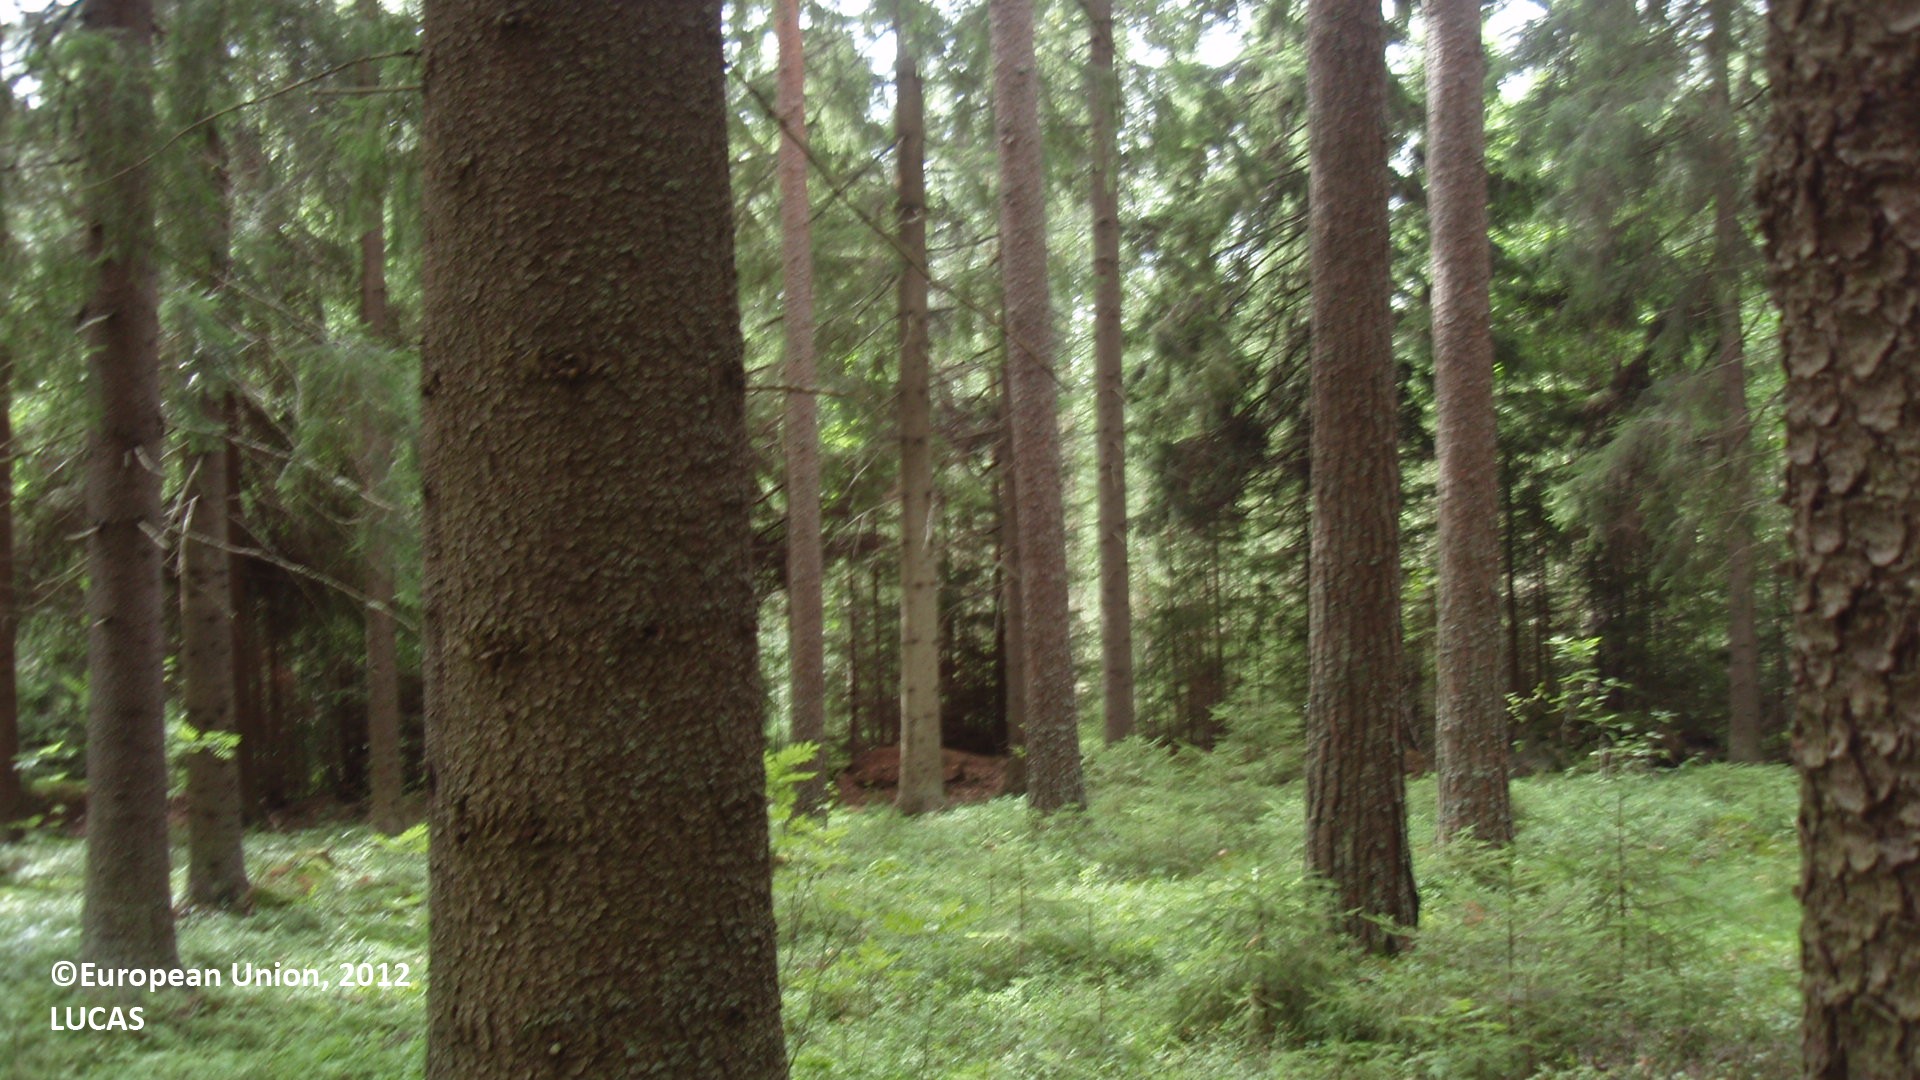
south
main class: Woodland
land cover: Spruce dominated mixed woodland
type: boreal forest
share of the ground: 50 - 75 %
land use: Agriculture (excluding fallow land and kitchen gardens)
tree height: > 5 m
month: August
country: FI
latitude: 61.0373
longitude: 27.4908
